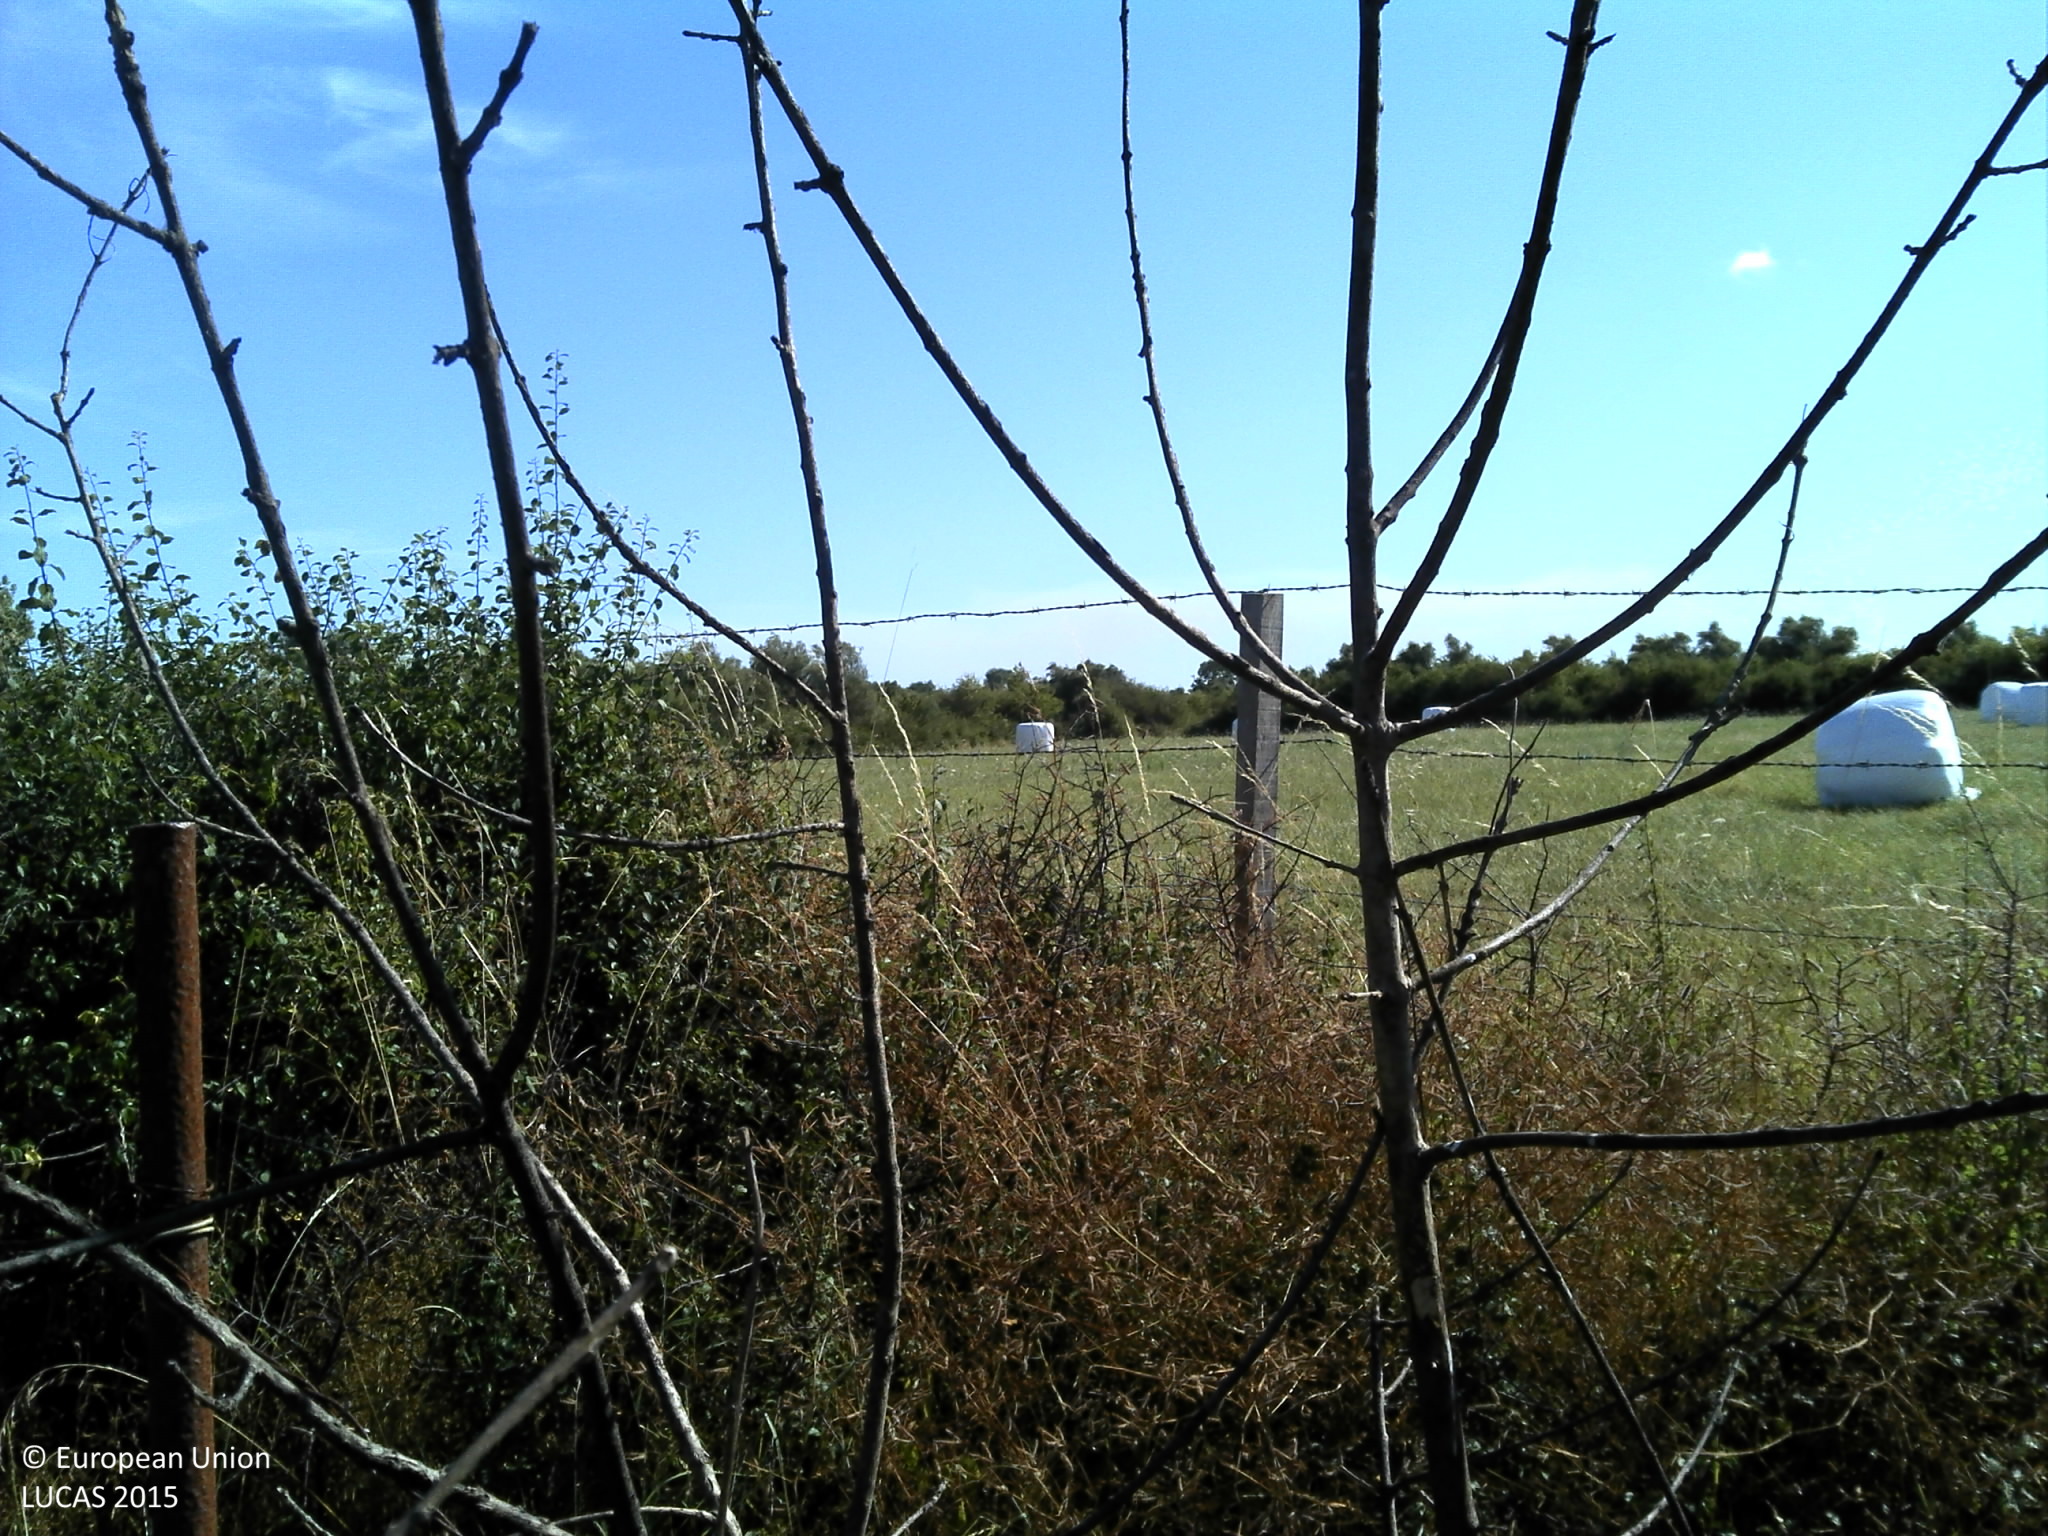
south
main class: Grassland
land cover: Grassland without tree/shrub cover
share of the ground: > 75 %
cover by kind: herbaceous plants 100 %
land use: Agriculture (excluding fallow land and kitchen gardens)
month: July
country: FR
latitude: 45.3476
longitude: -0.8087
